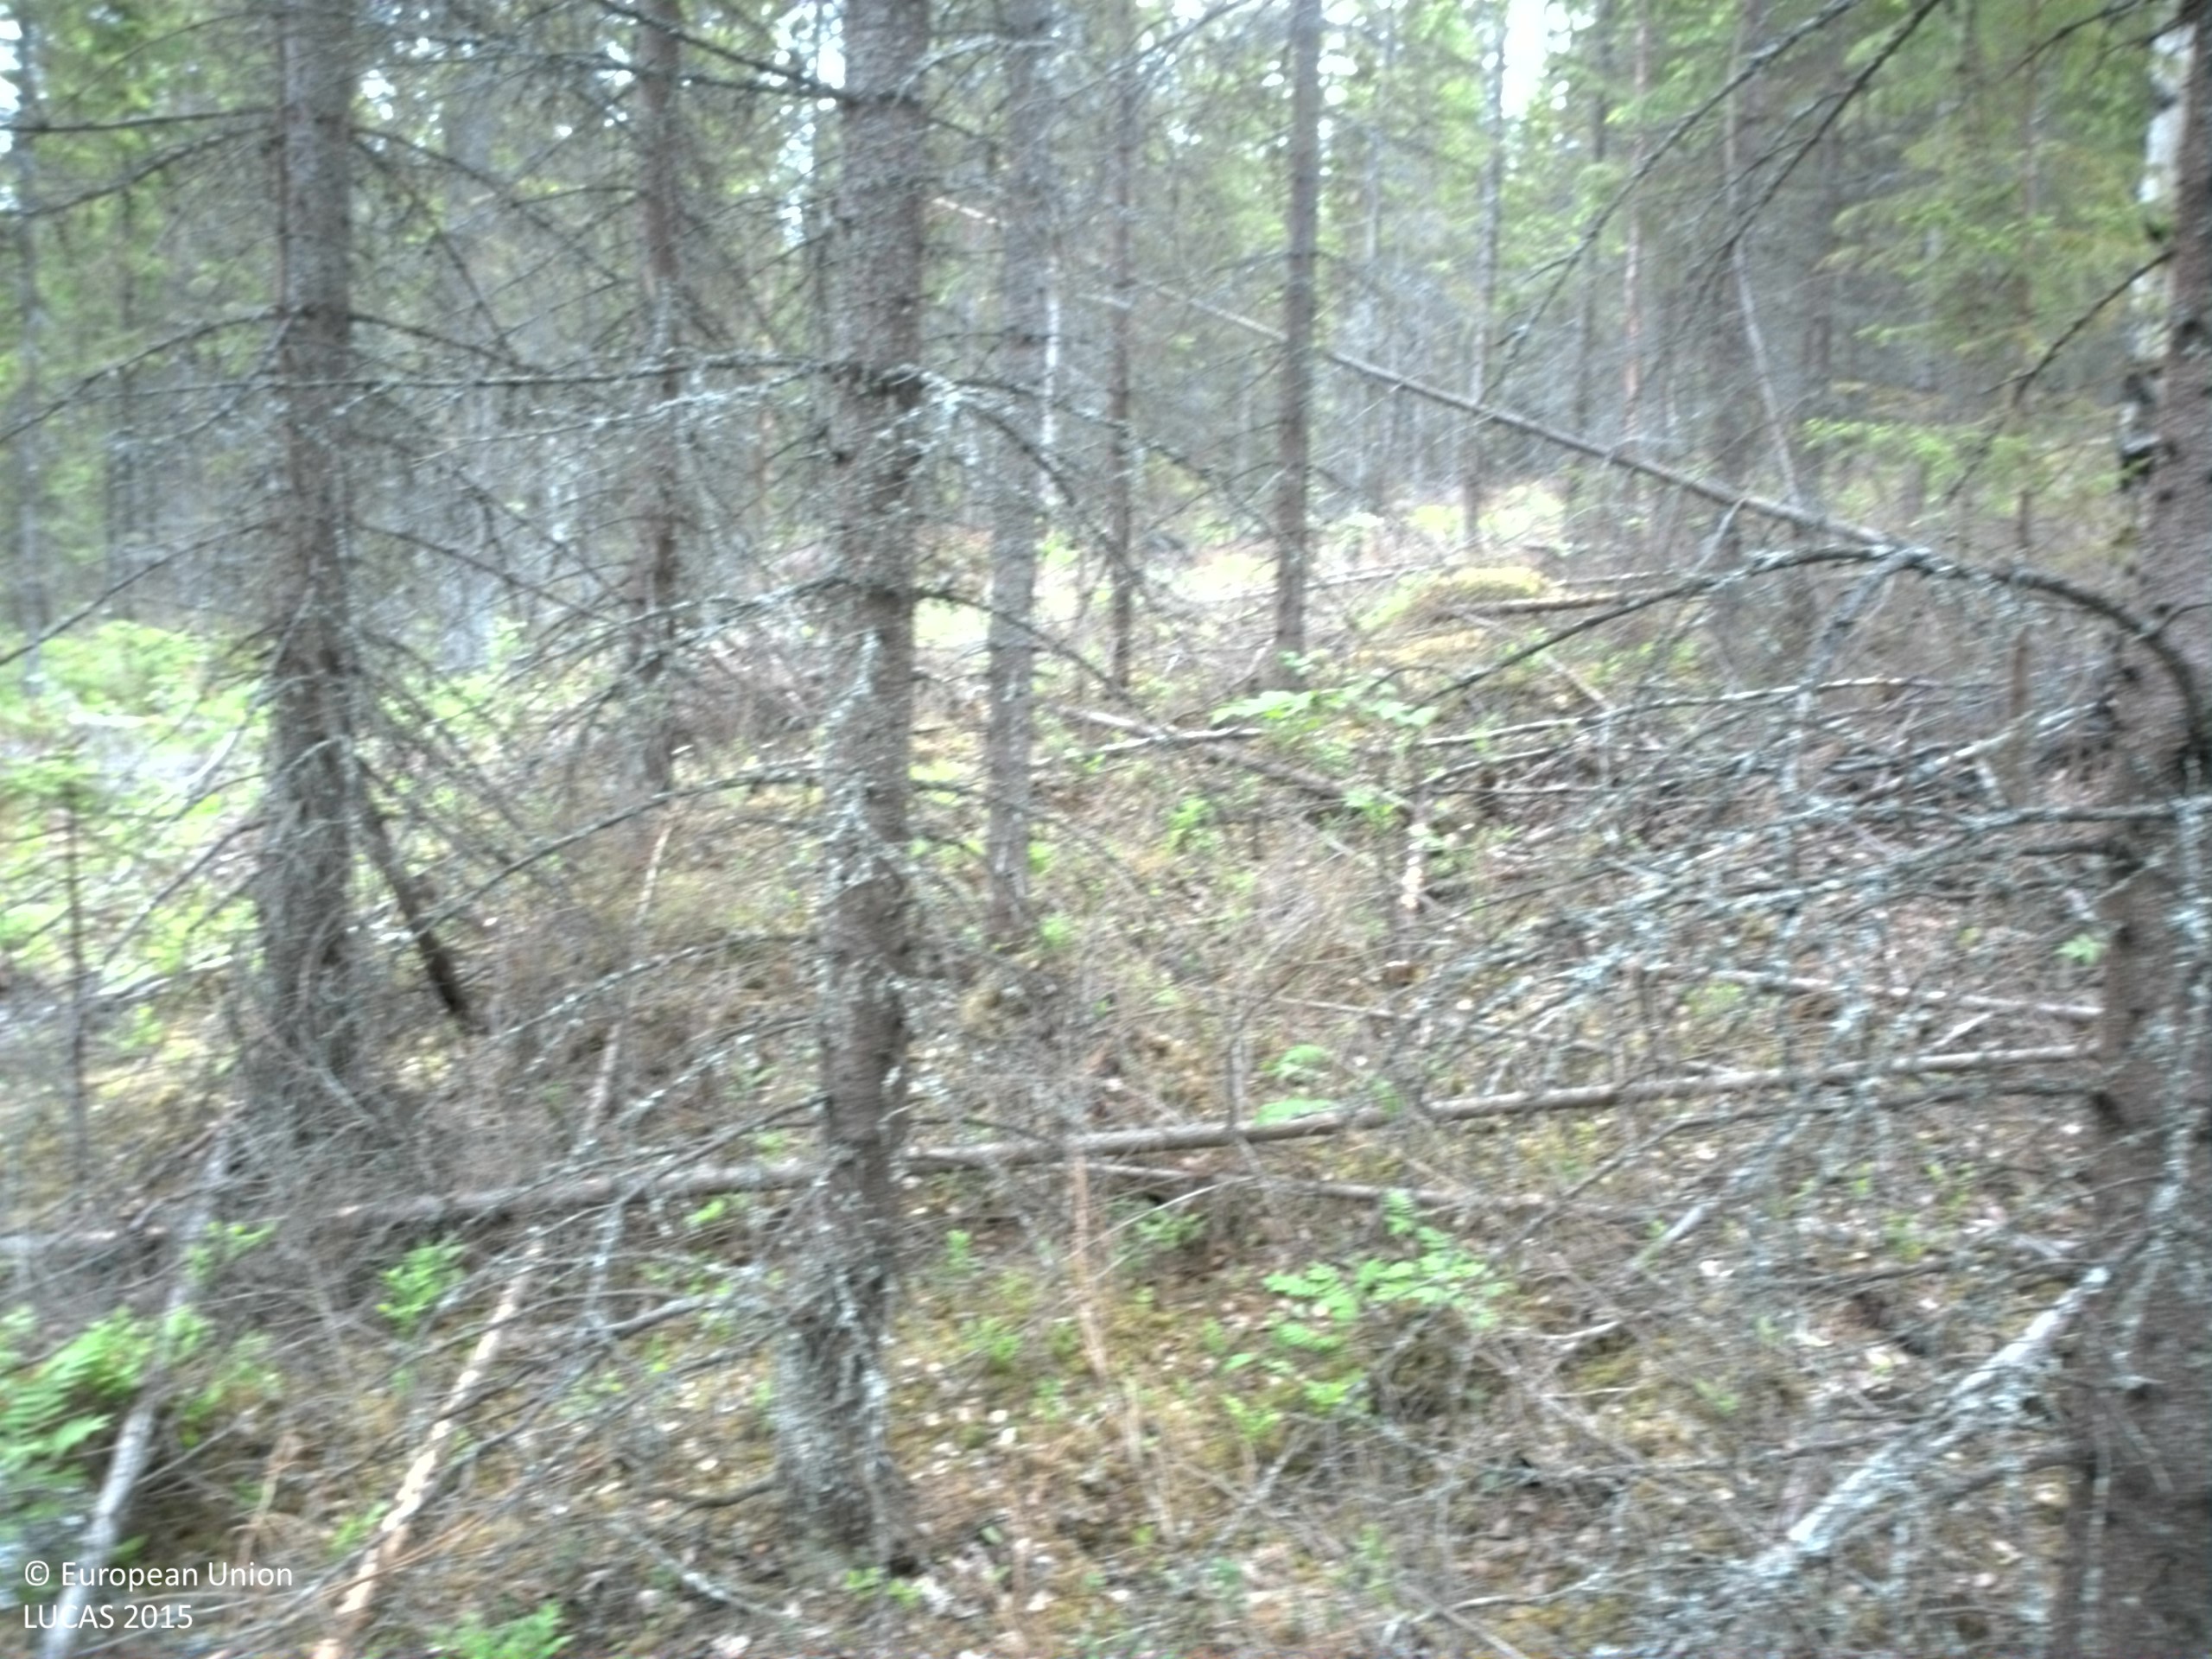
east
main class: Woodland
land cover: Spruce dominated coniferous woodland
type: boreal forest
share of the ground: > 75 %
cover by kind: coniferous forest trees 70 %, shrubs 15 %, broadleaved forest trees 5 %
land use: Forestry
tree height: > 5 m
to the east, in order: Spruce dominated coniferous woodland; Other mixed woodland
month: June
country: SE
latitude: 63.1508
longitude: 17.8557
